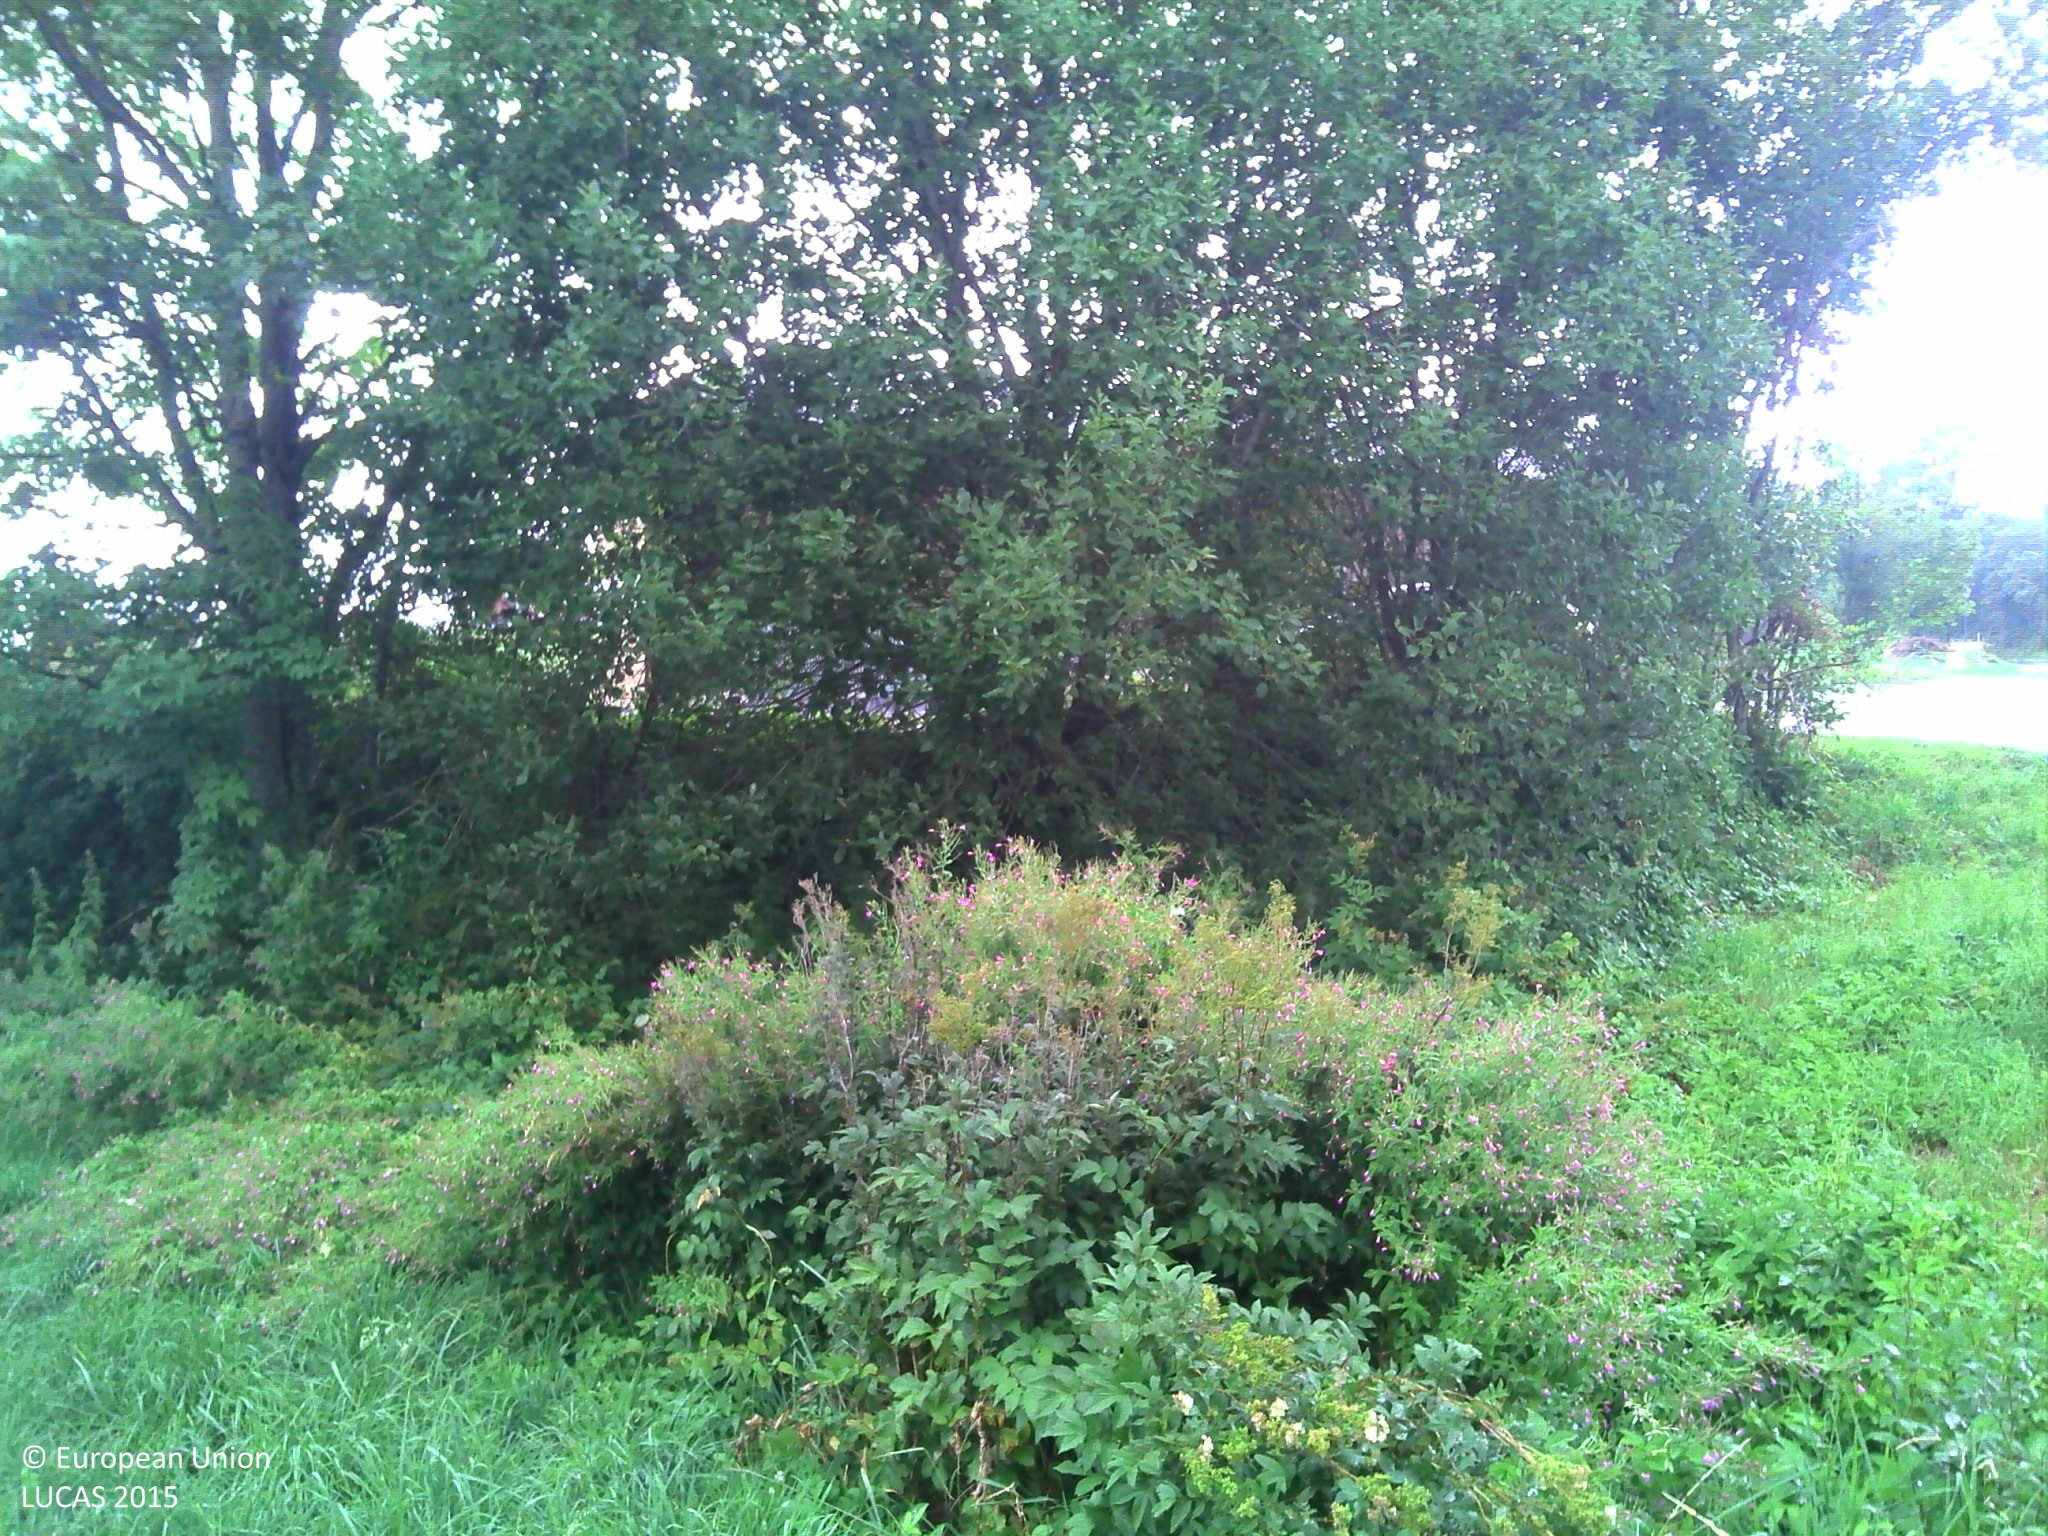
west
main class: Grassland
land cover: Grassland without tree/shrub cover
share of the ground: > 75 %
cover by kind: herbaceous plants 100 %
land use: Agriculture (excluding fallow land and kitchen gardens)
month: July
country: FR
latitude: 46.0490
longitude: 6.1912
